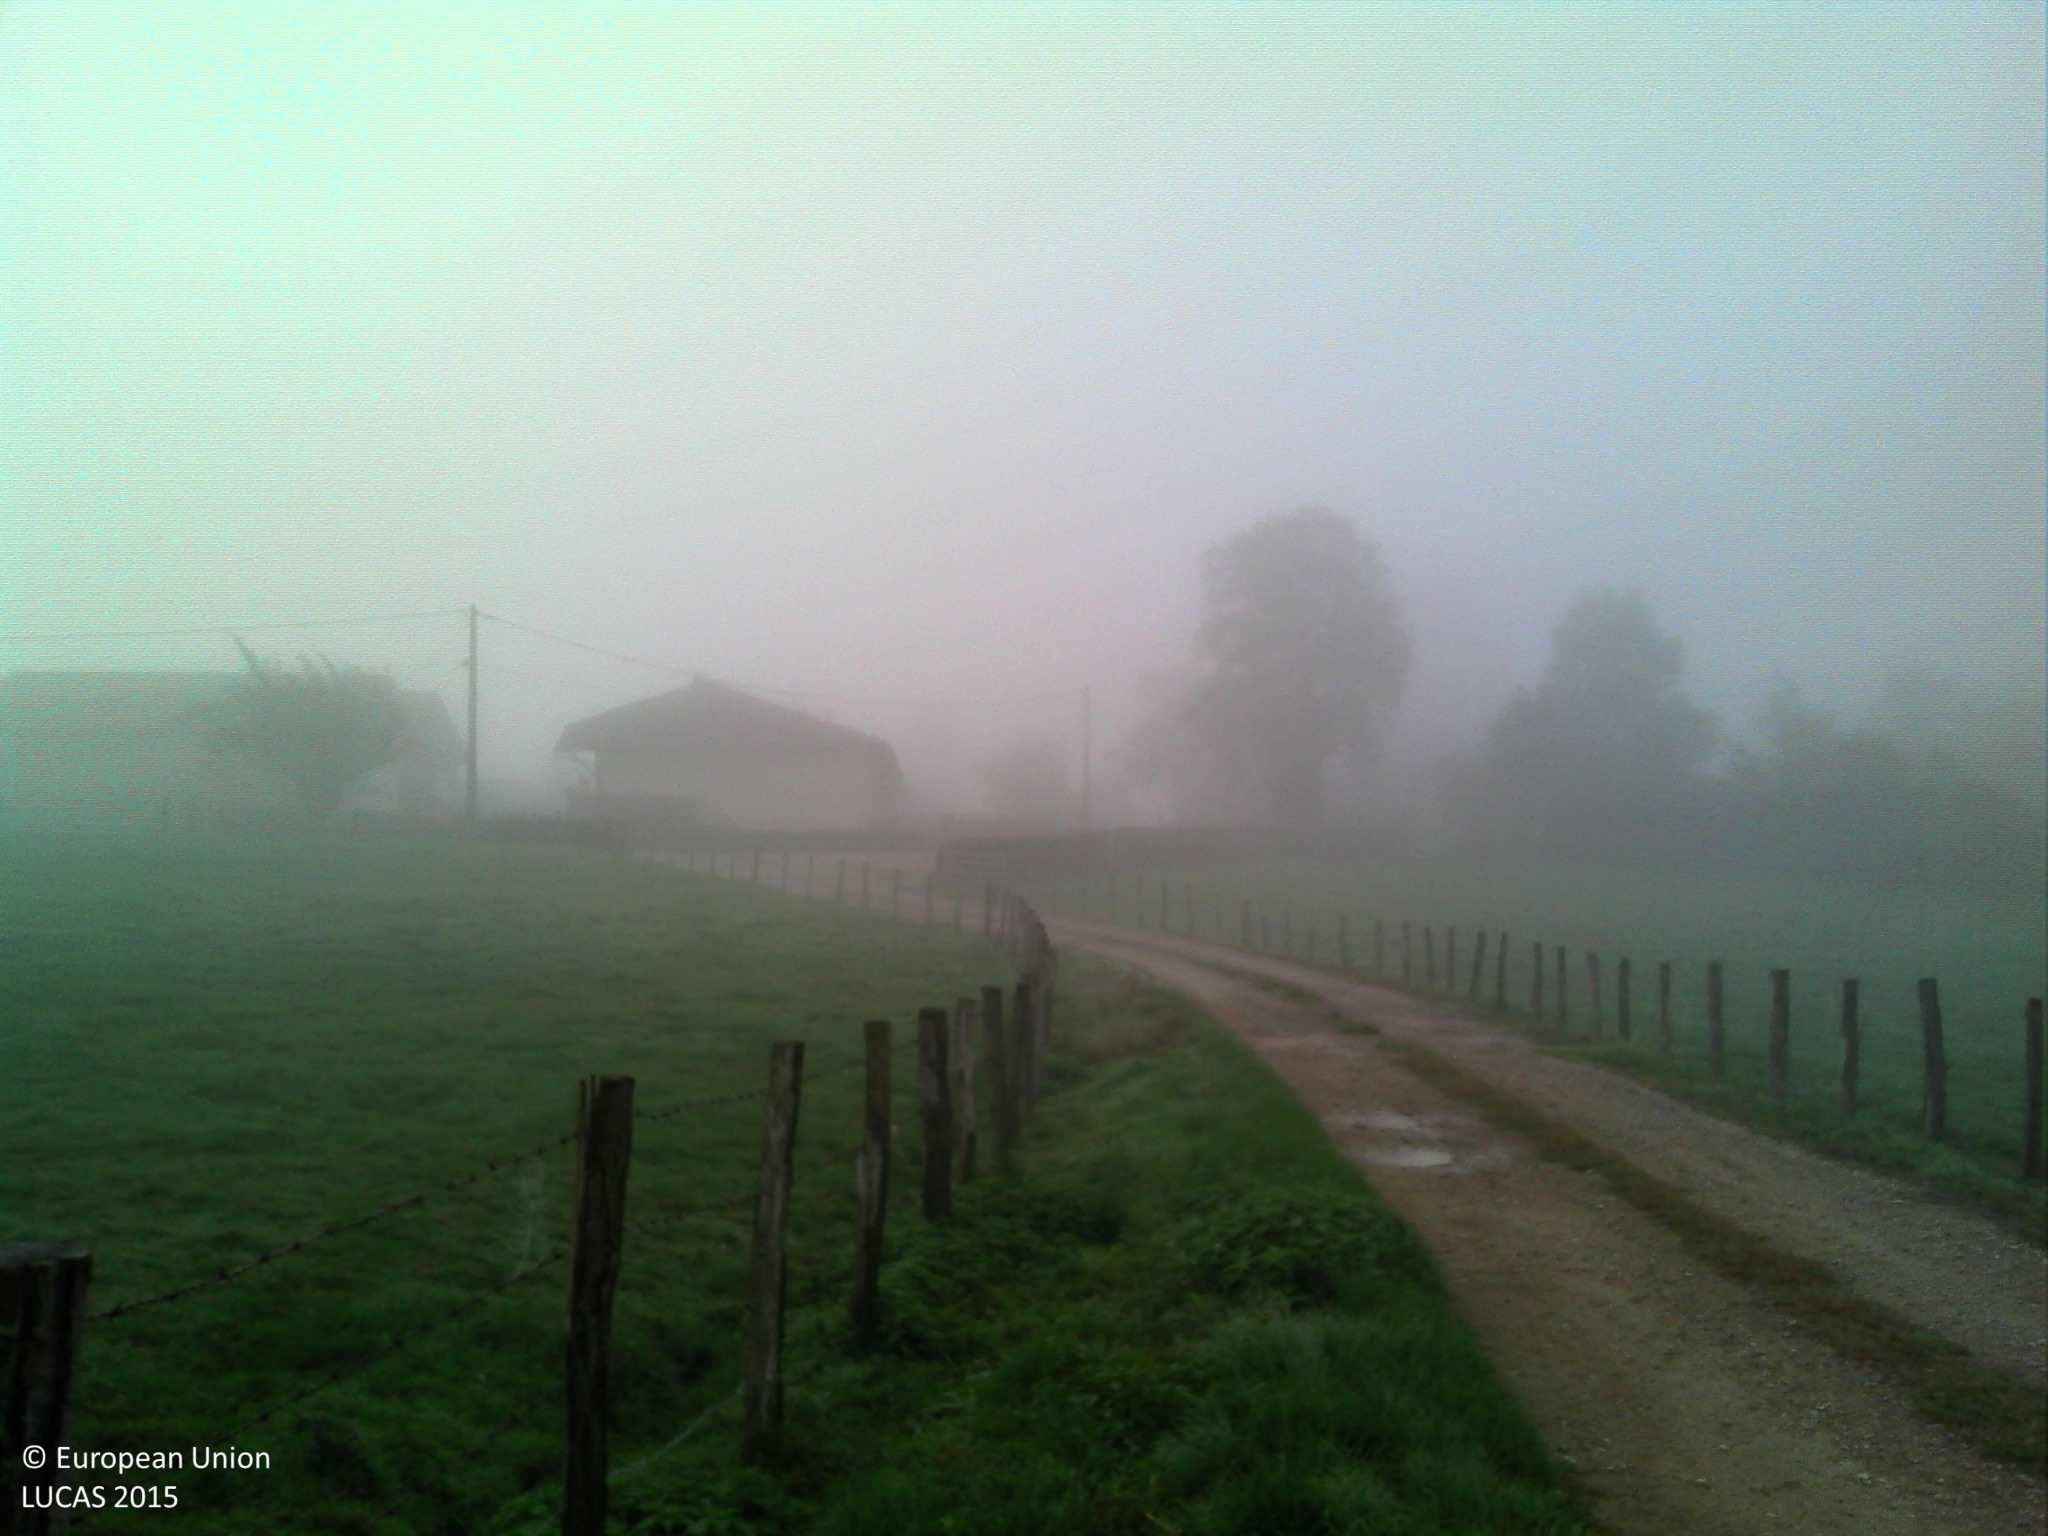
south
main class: Grassland
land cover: Grassland without tree/shrub cover
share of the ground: > 75 %
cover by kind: herbaceous plants 100 %
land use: Agriculture (excluding fallow land and kitchen gardens)
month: October
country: FR
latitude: 46.3376
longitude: 5.2868
